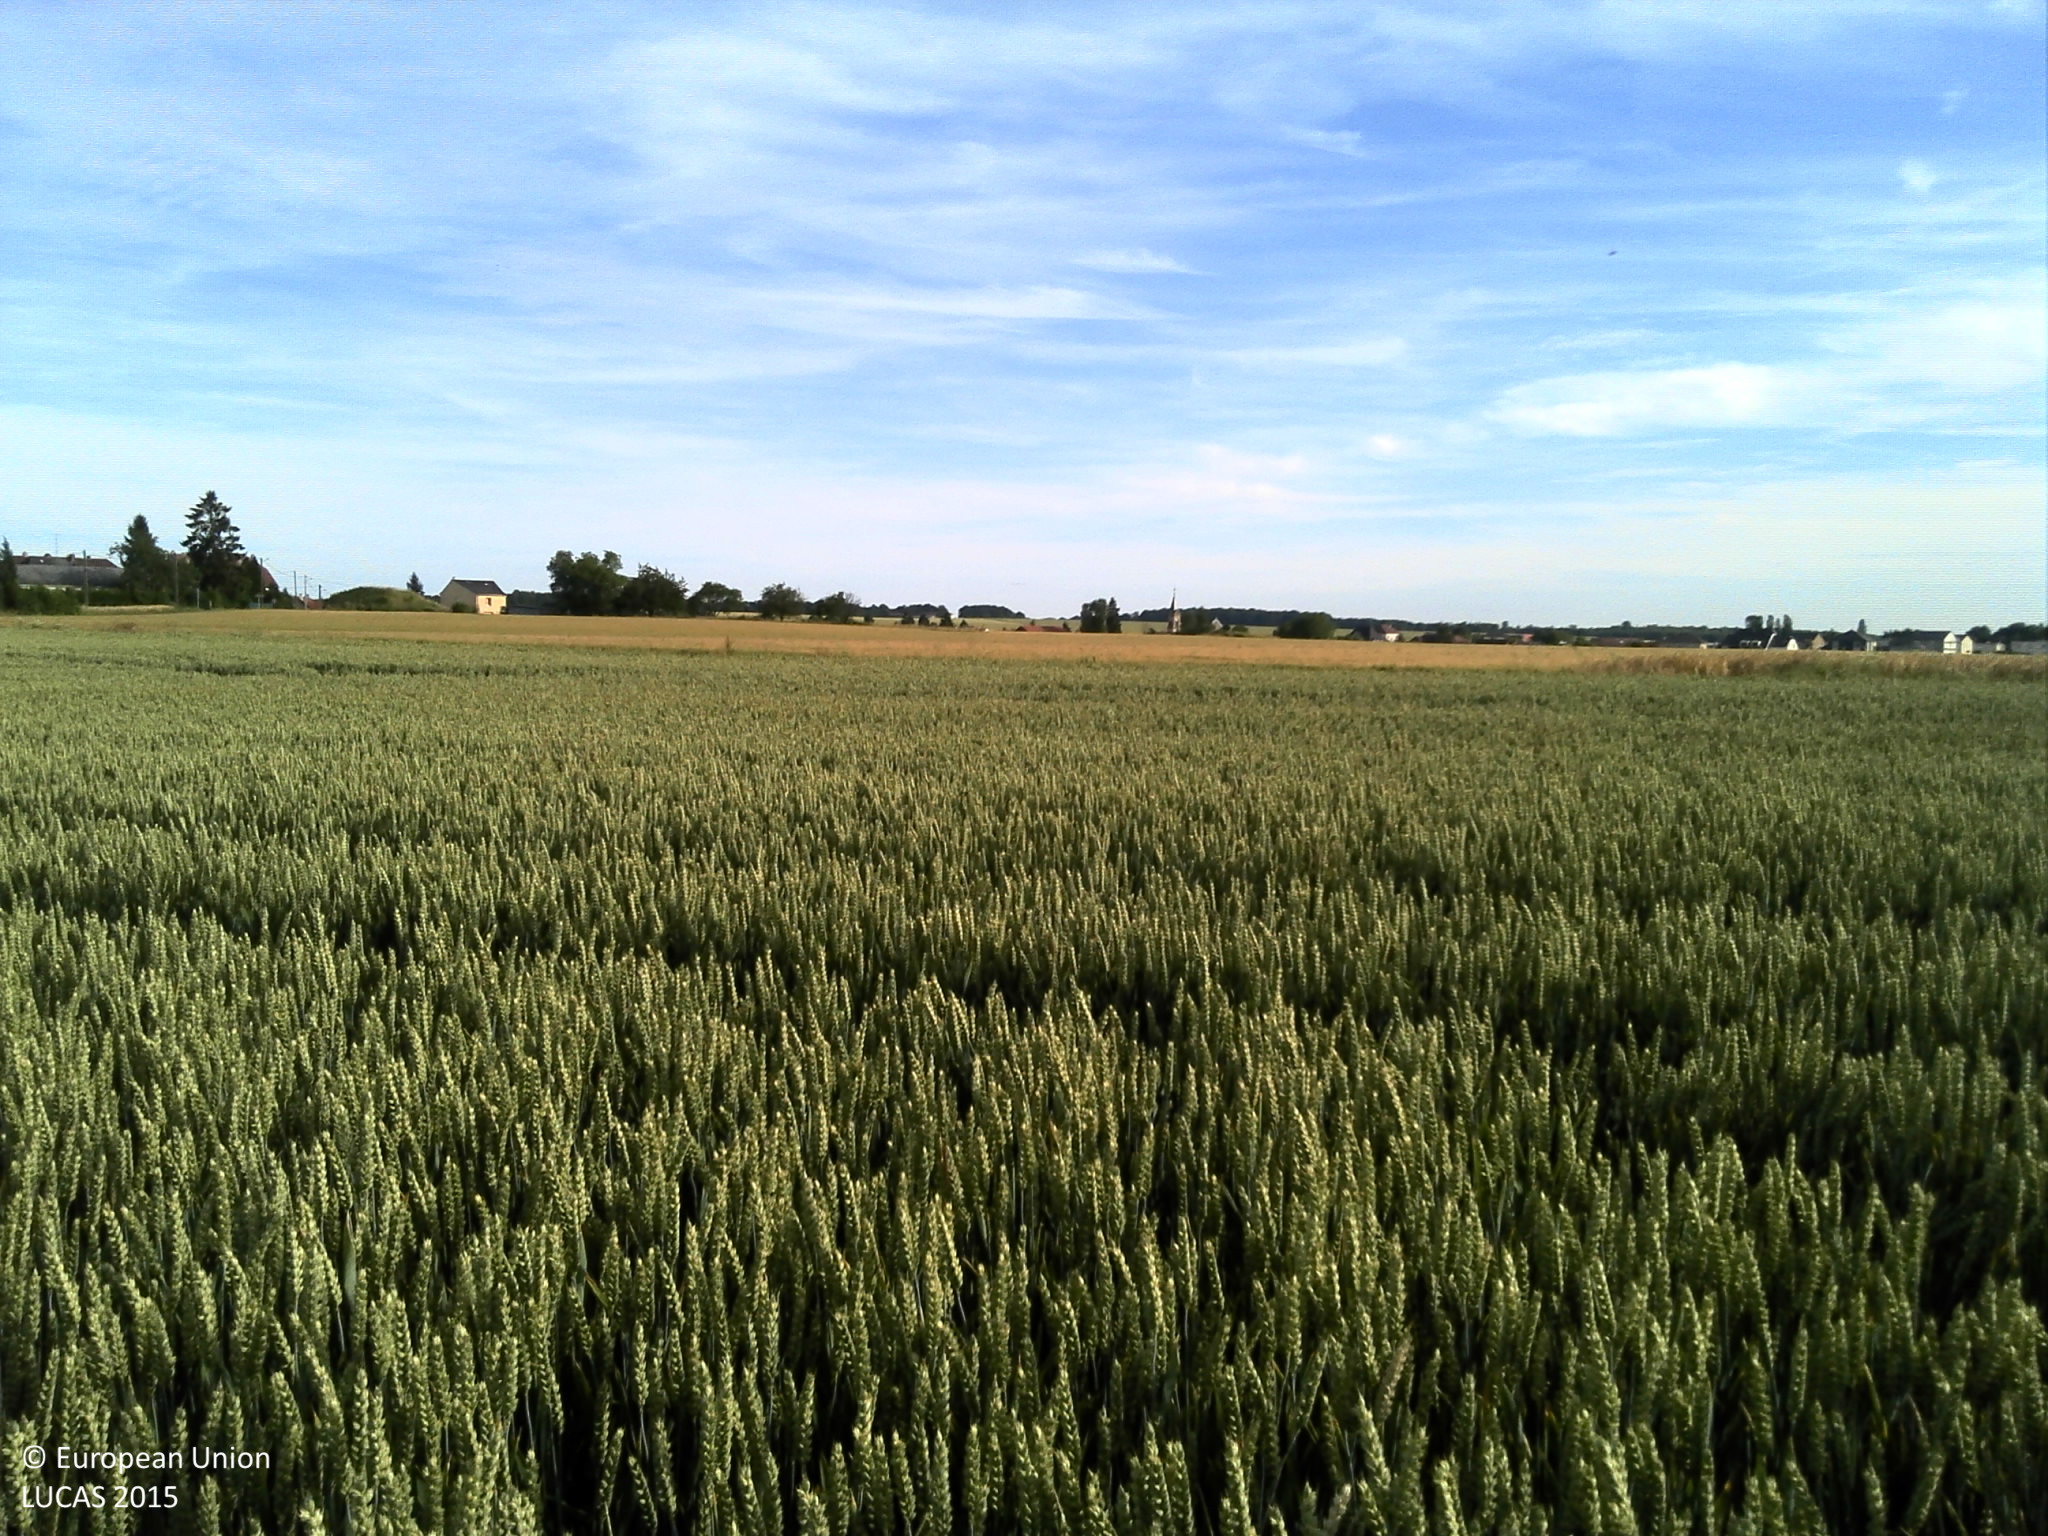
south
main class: Cropland
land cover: Common wheat
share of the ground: > 75 %
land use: Agriculture (excluding fallow land and kitchen gardens)
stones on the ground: < 10 %
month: June
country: FR
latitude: 49.3954
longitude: 6.0450
